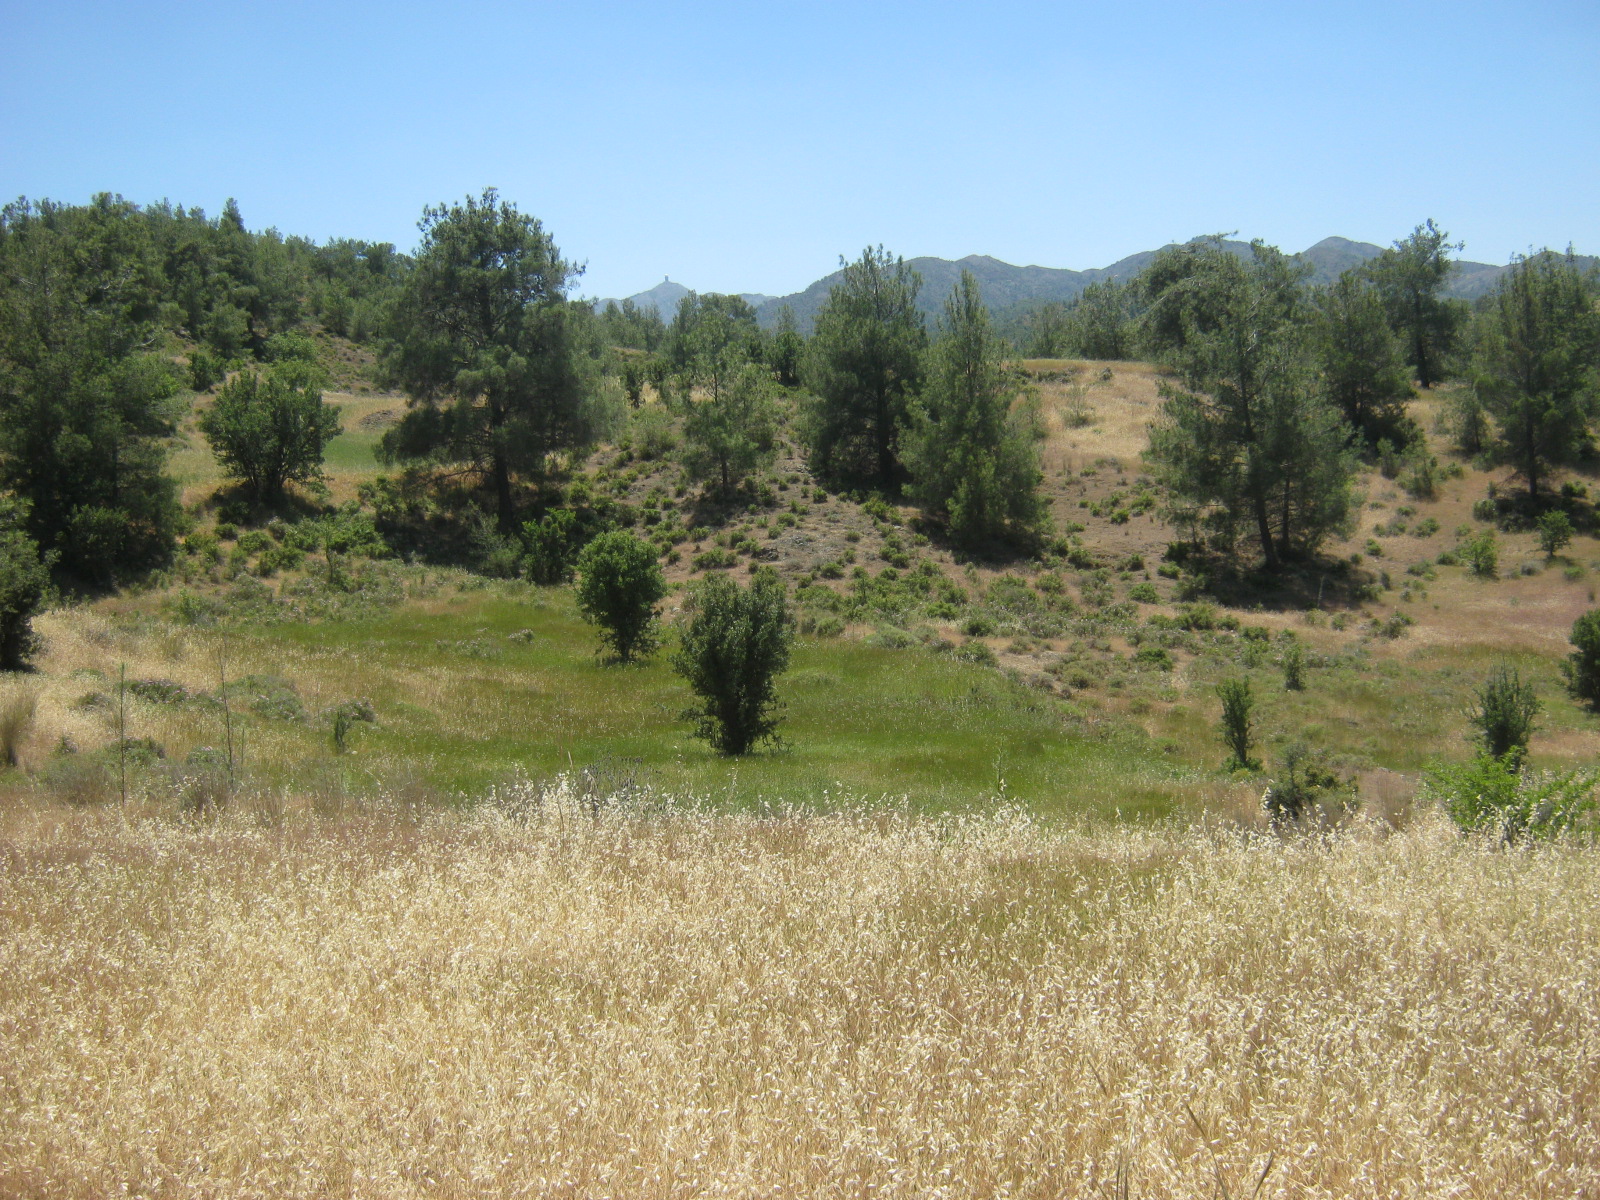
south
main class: Grassland
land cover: Grassland with sparse tree/shrub cover
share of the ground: > 75 %
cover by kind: herbaceous plants 80 %, unconsolidated bare surface 10 %, coniferous forest trees 5 %, shrubs 5 %
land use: Semi-natural and natural areas not in use
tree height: > 5 m
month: May
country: CY
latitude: 35.0044
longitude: 33.2034
